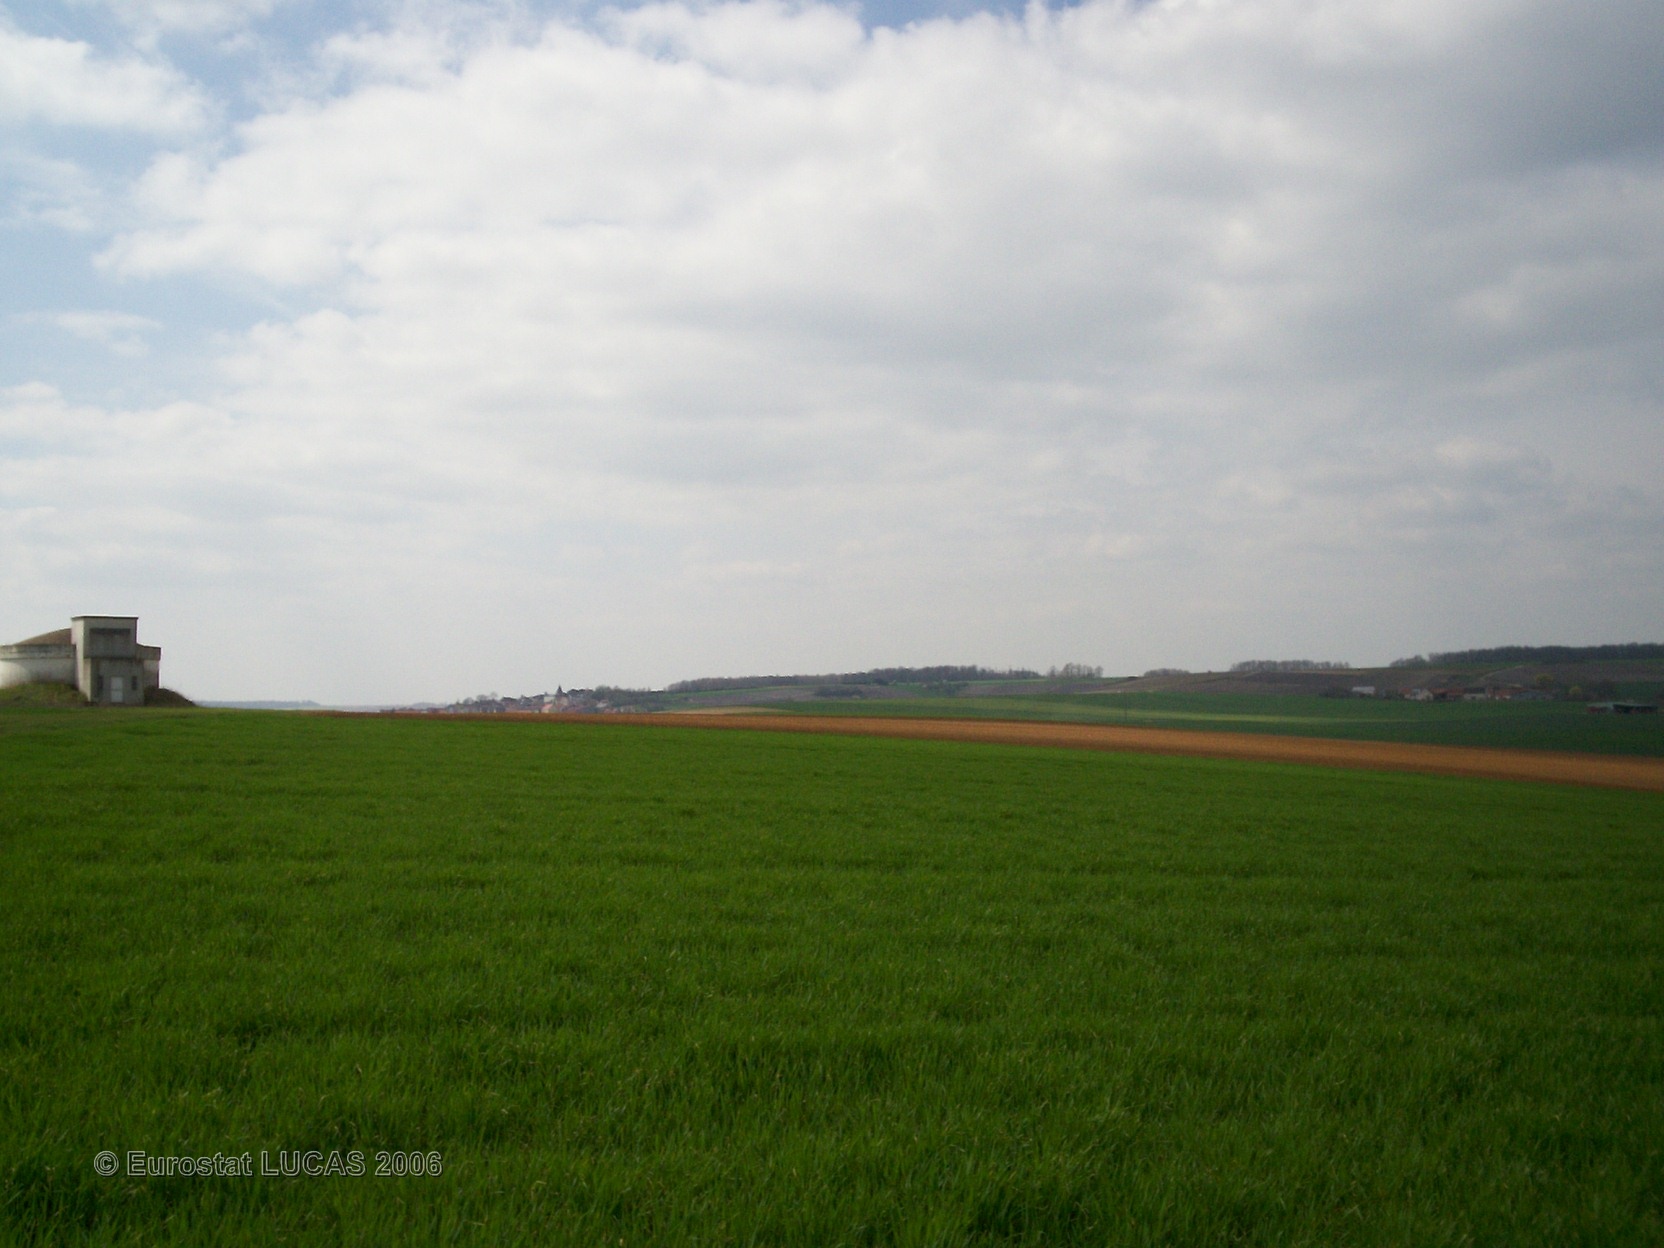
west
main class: Cropland
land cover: Barley
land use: Agriculture (excluding fallow land and kitchen gardens)
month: April
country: FR
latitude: 48.8860
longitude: 3.9262
